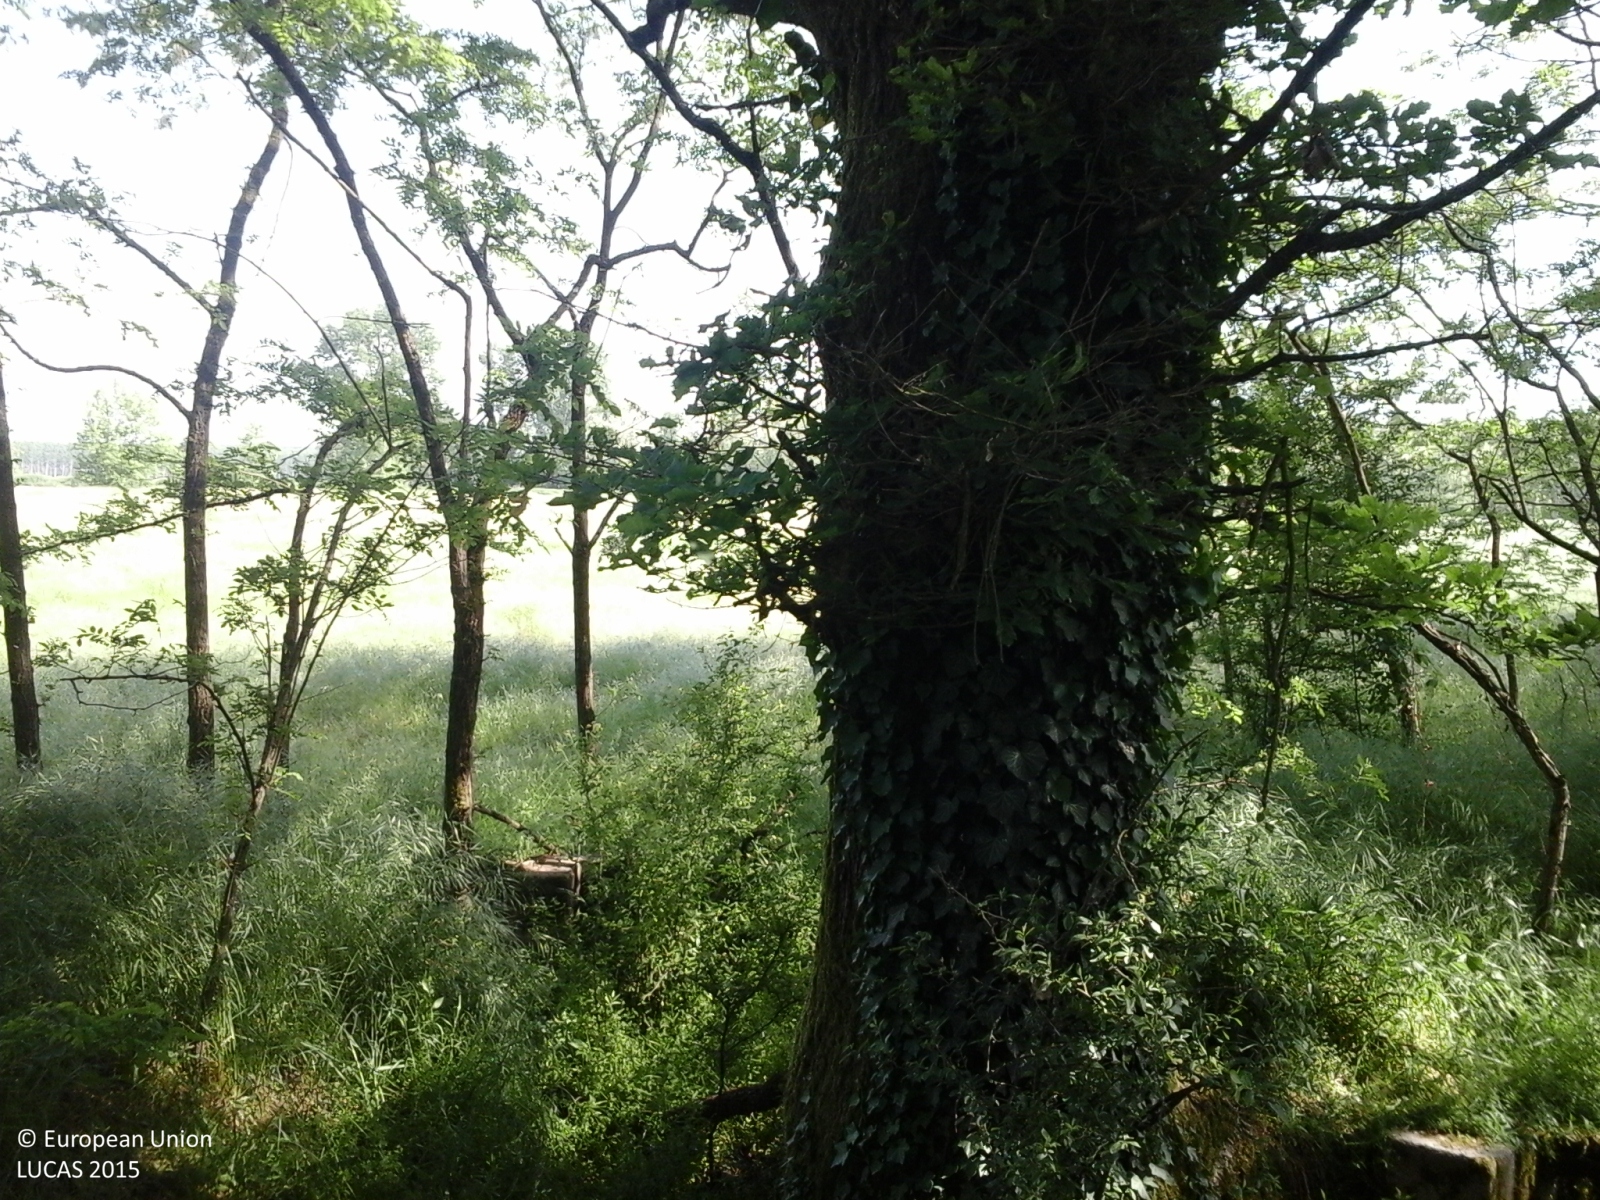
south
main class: Woodland
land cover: Broadleaved woodland
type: floodplain forest
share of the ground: 25 - 50 %
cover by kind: broadleaved forest trees 50 %, herbaceous plants 50 %
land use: Forestry
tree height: > 5 m
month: May
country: IT
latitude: 45.2122
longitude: 9.0976
